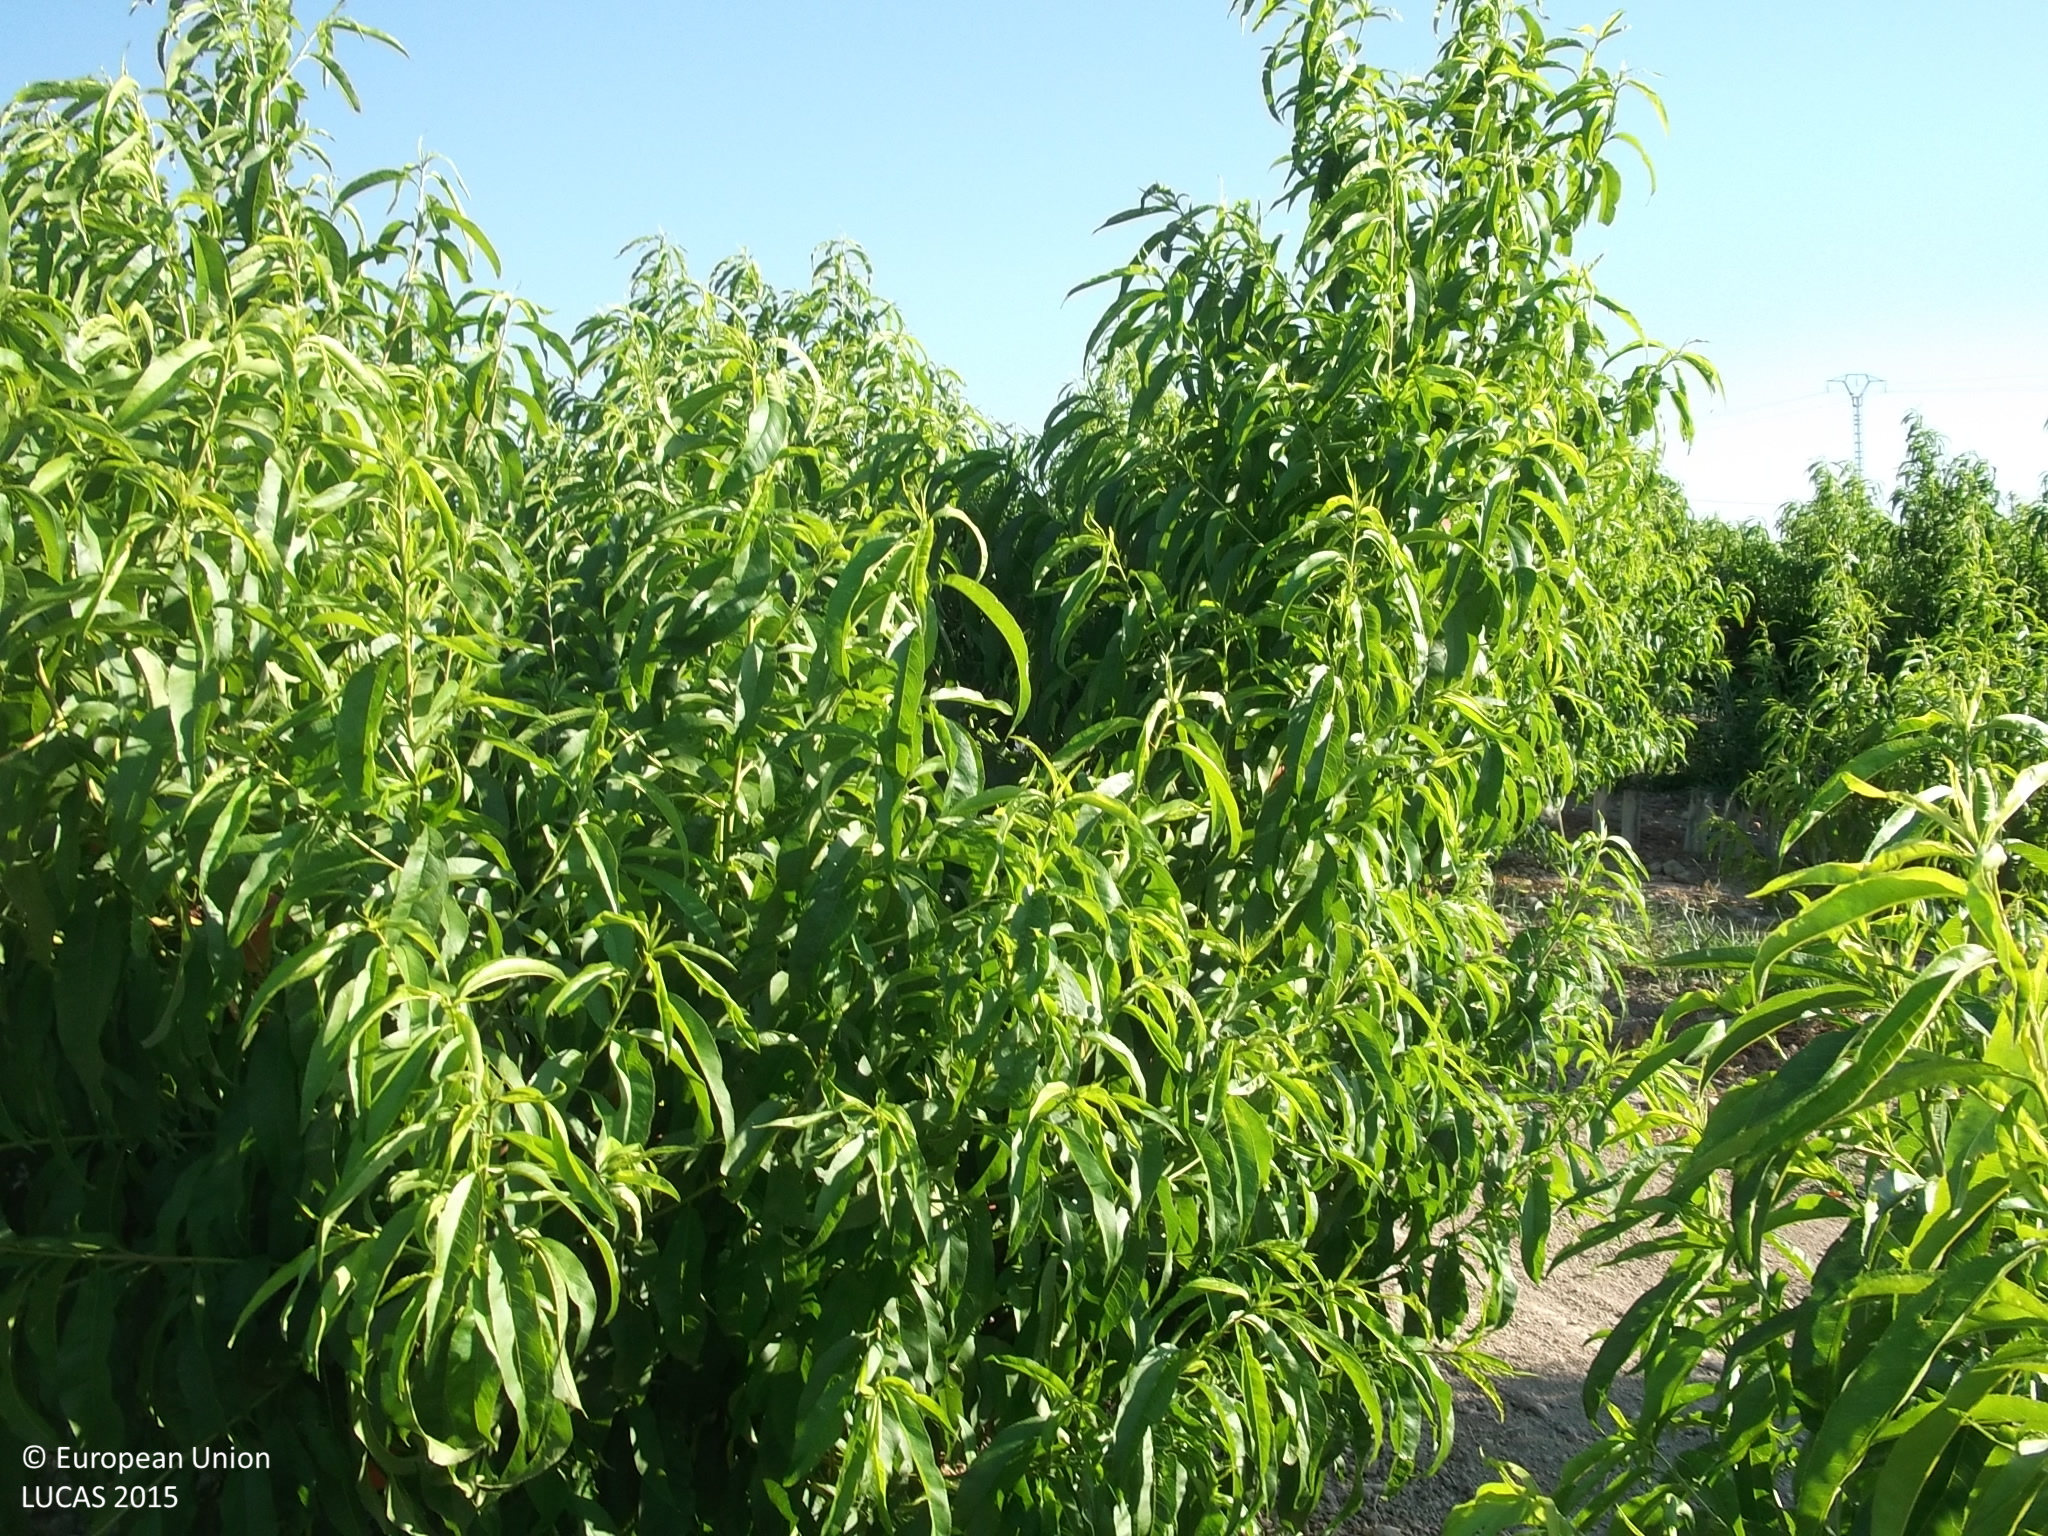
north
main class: Cropland
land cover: Other fruit trees and berries
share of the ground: 10 - 25 %
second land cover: Other bare soil
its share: > 75 %
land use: Agriculture (excluding fallow land and kitchen gardens)
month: June
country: ES
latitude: 38.2373
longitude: -1.4937
